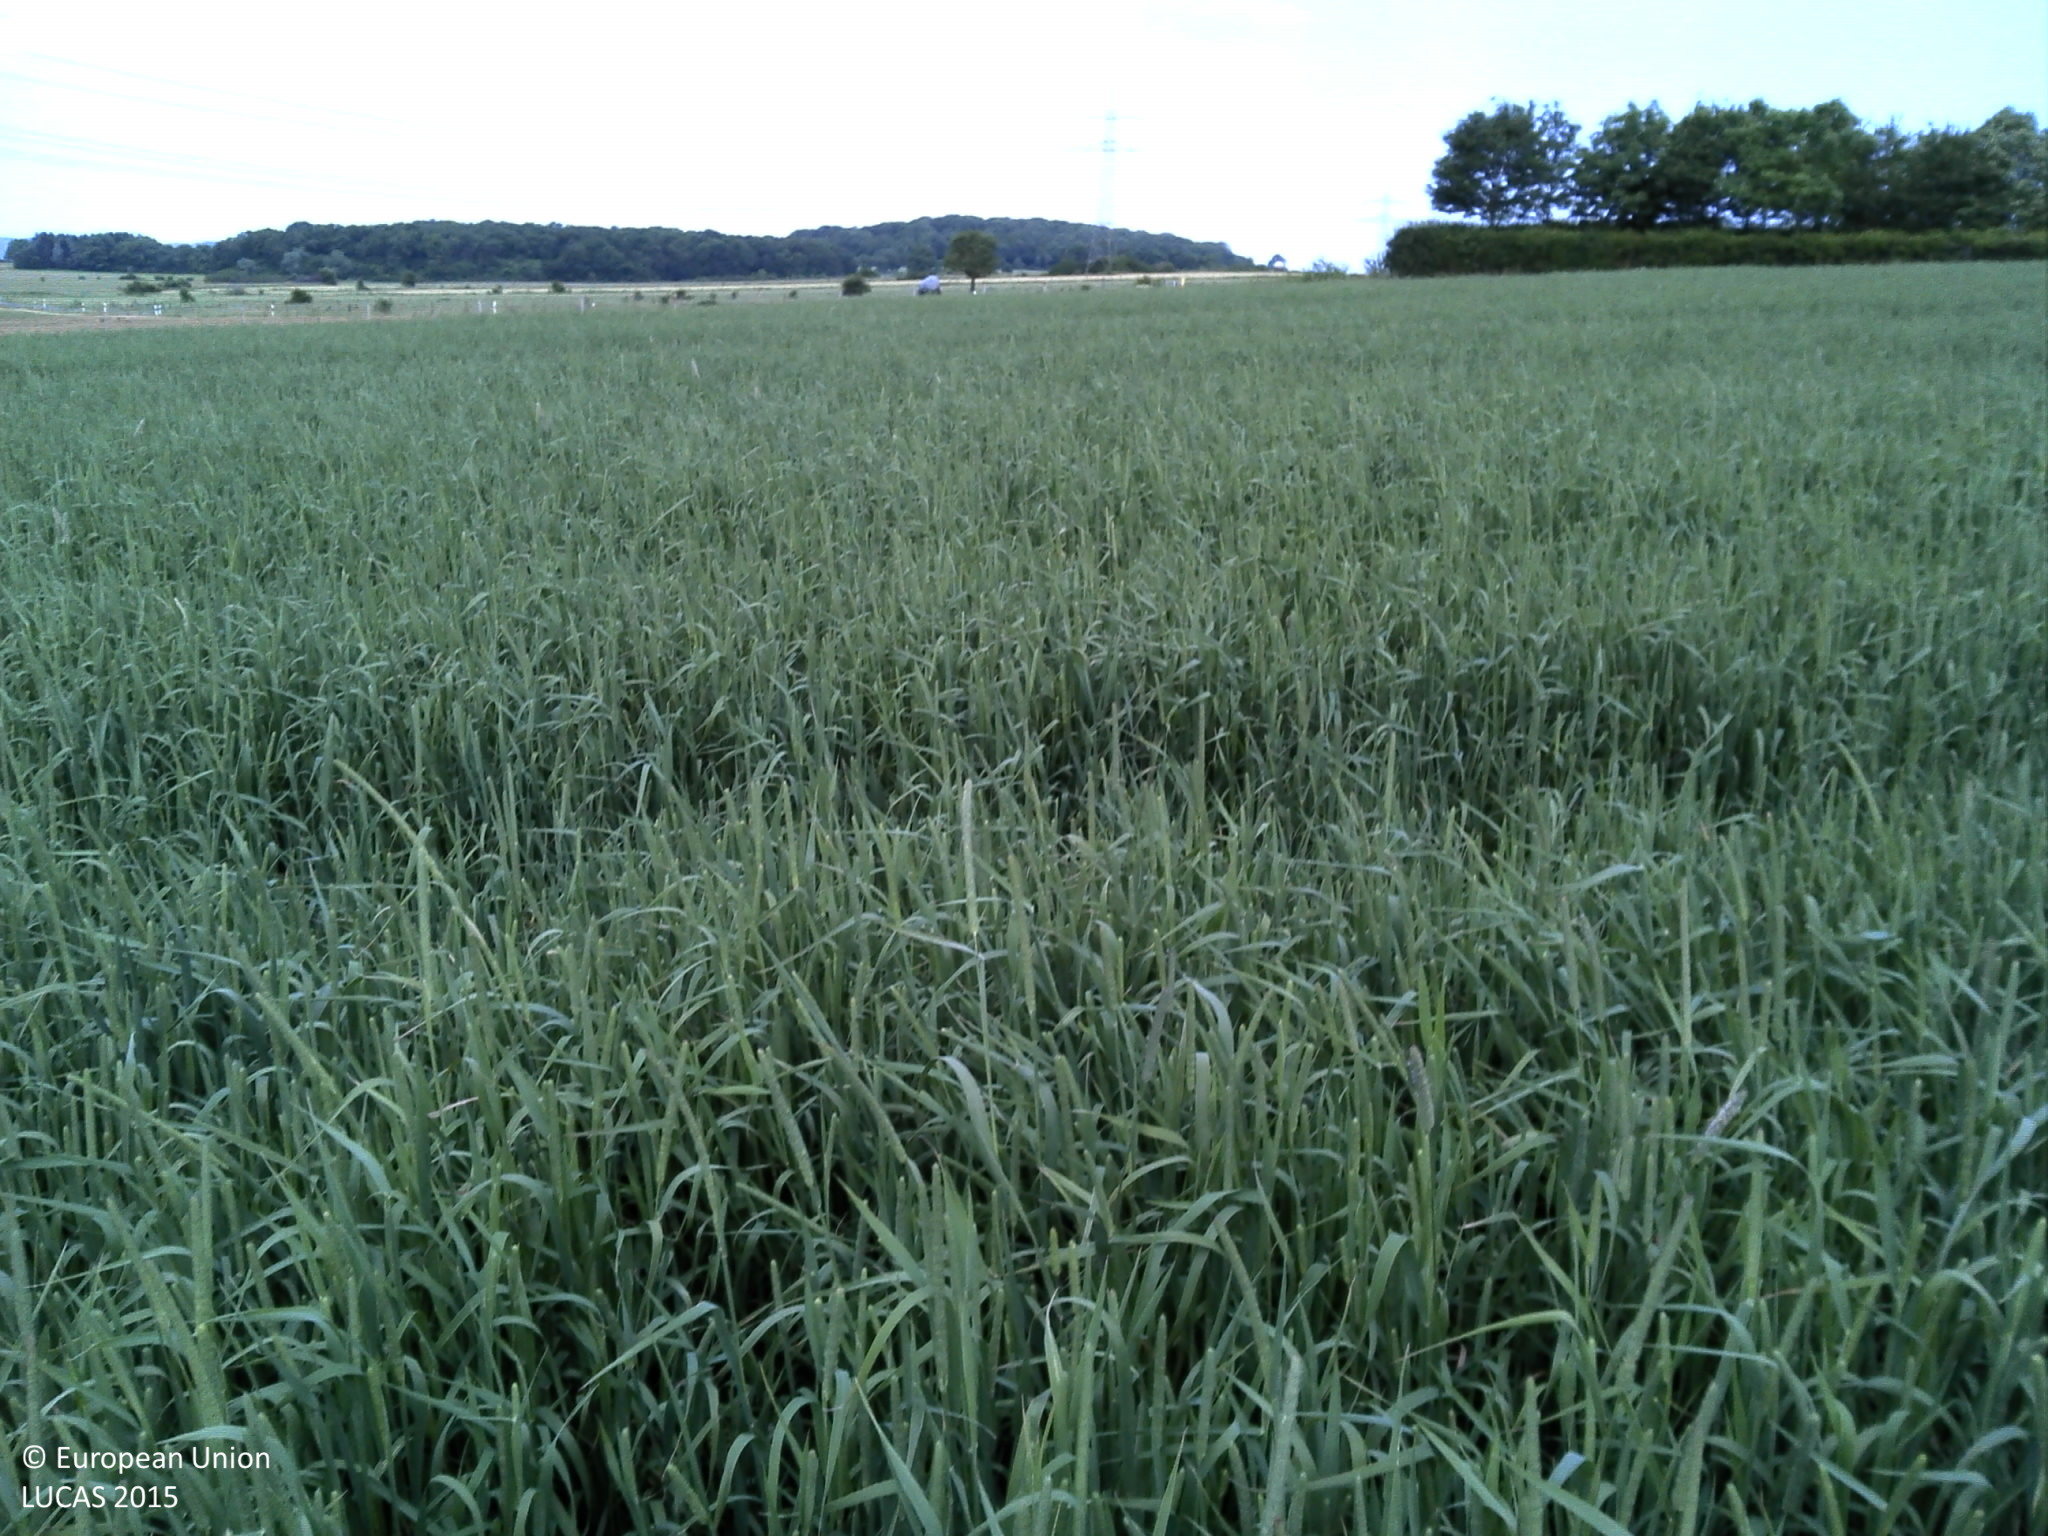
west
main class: Cropland
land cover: Temporary grasslands
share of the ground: > 75 %
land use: Agriculture (excluding fallow land and kitchen gardens)
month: June
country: LU
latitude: 49.5551
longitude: 5.9766
